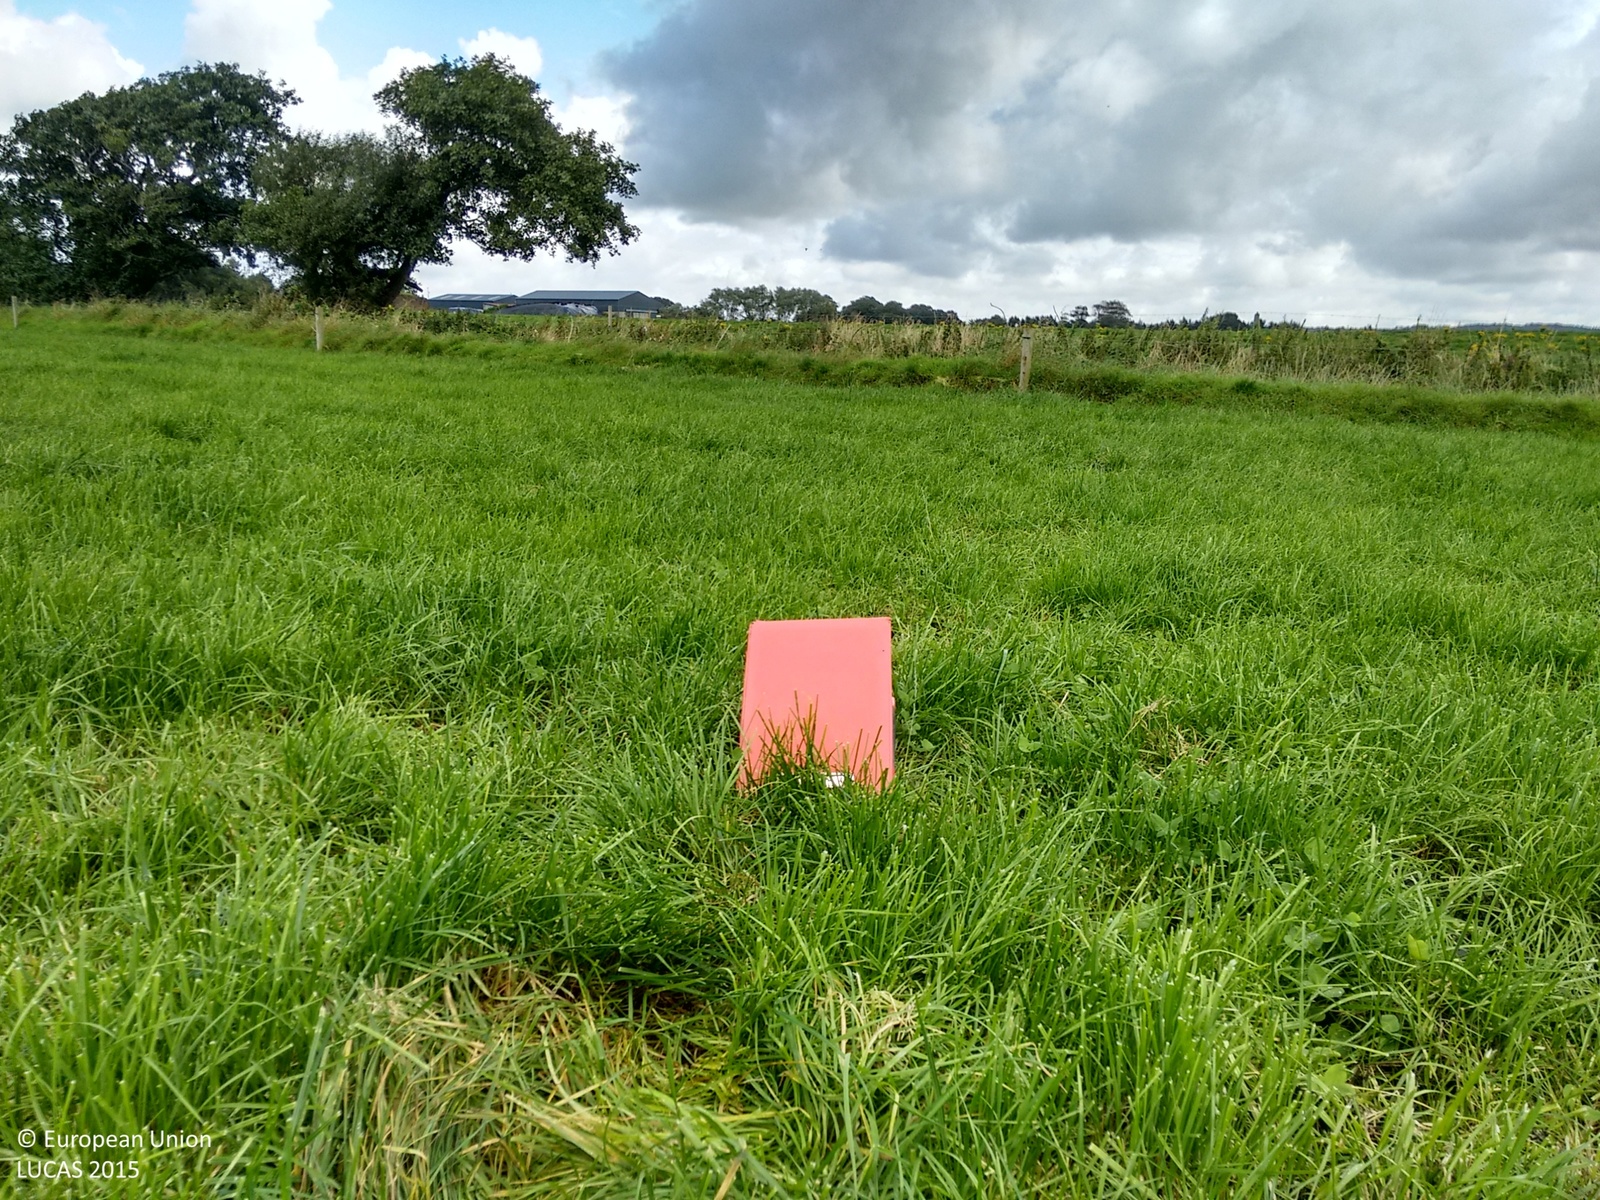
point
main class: Grassland
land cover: Grassland without tree/shrub cover
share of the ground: > 75 %
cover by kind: herbaceous plants 100 %
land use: Agriculture (excluding fallow land and kitchen gardens)
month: September
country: IE
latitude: 52.4383
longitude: -9.5189
